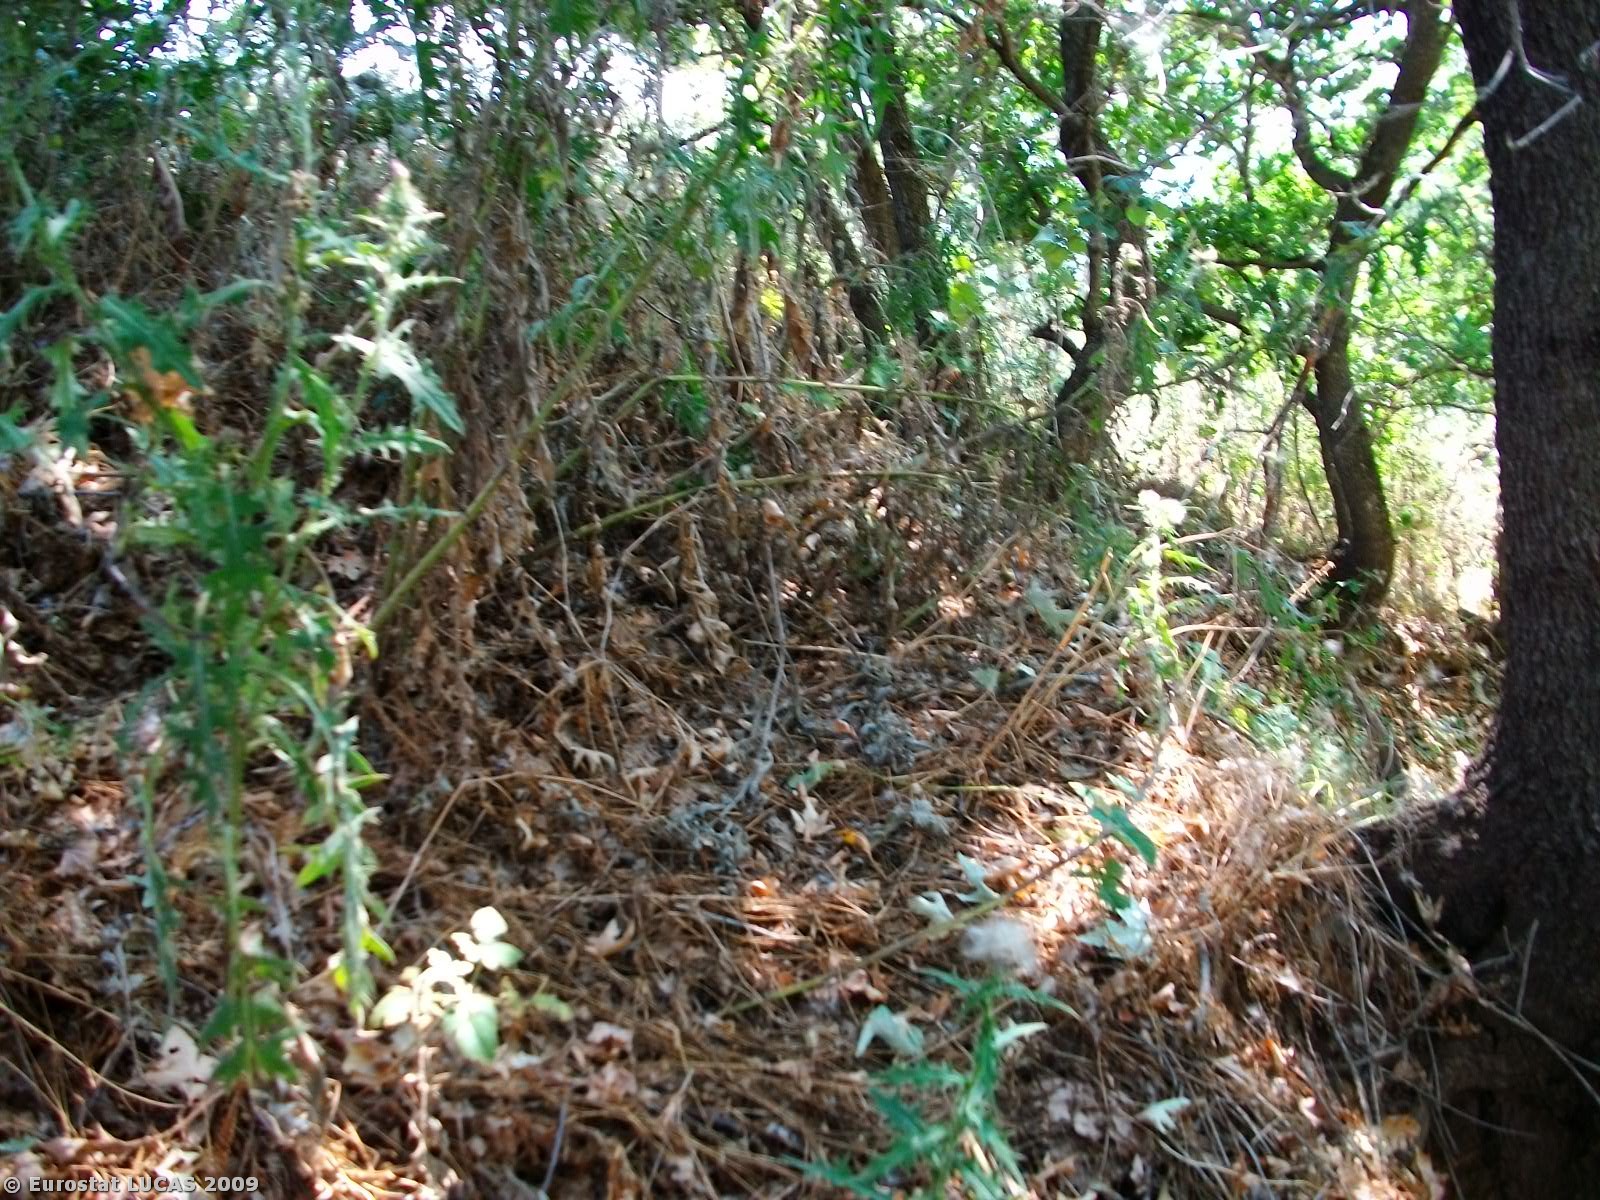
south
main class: Woodland
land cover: Broadleaved woodland
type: broadleaved evergreen forest
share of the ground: > 75 %
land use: Forestry
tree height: > 5 m
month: August
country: GR
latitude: 38.6812
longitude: 22.4736
